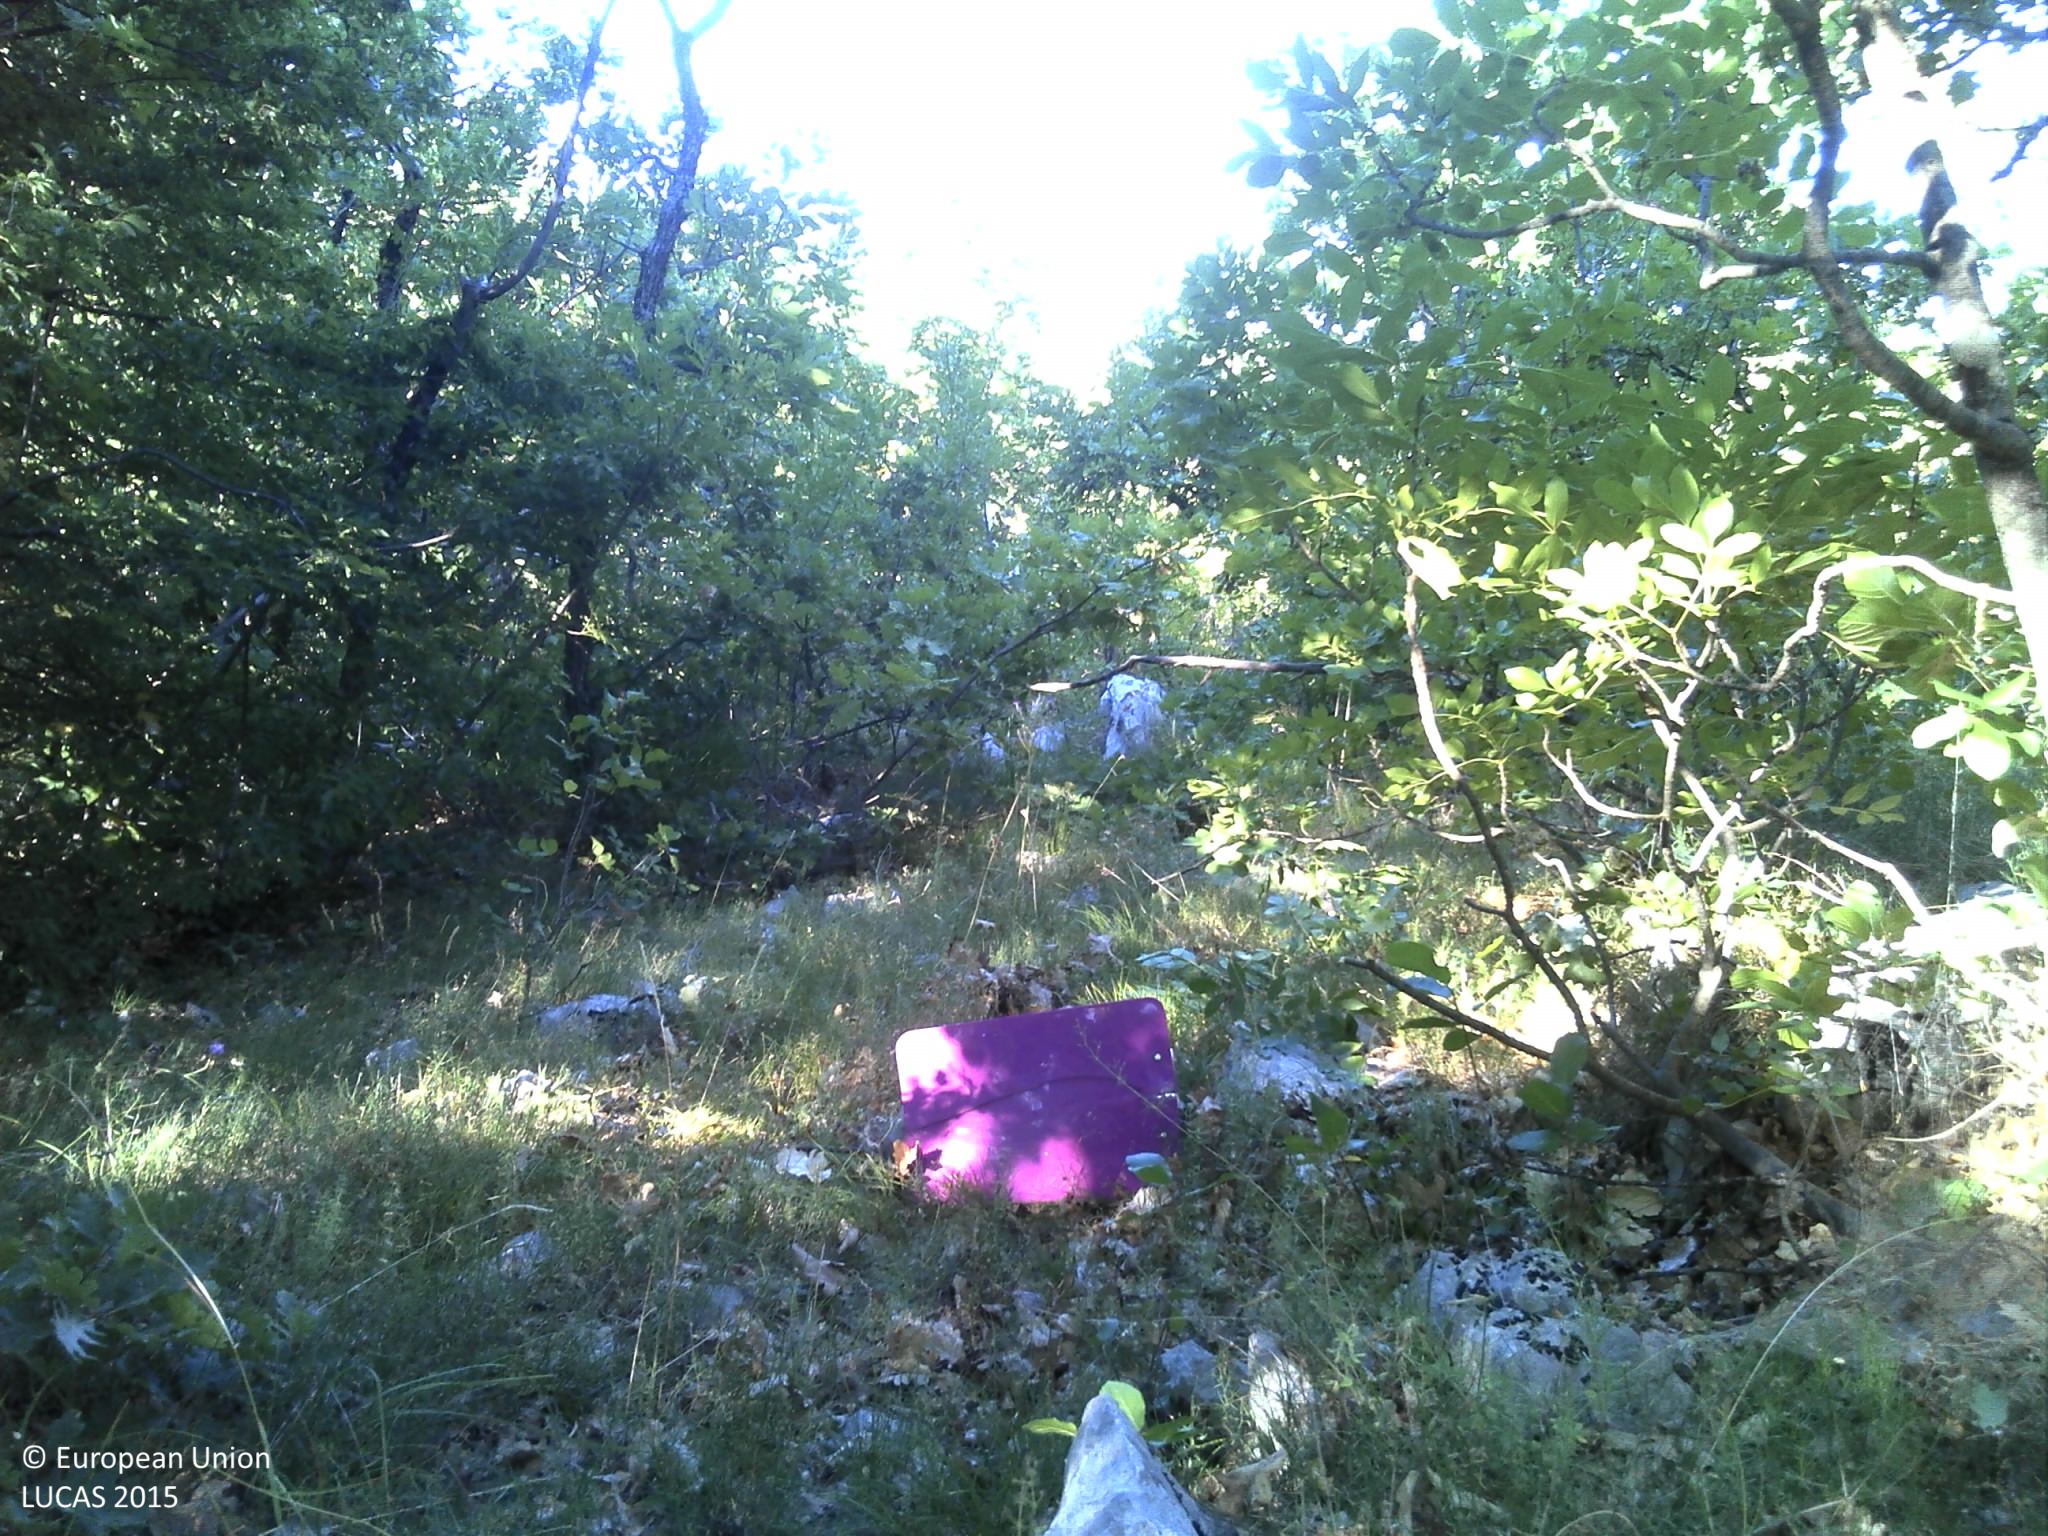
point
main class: Woodland
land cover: Other mixed woodland
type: thermophilous deciduous forest
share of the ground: > 75 %
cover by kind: broadleaved forest trees 55 %, coniferous forest trees 20 %, shrubs 10 %, herbaceous plants 10 %, consolidated bare surface 5 %
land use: Semi-natural and natural areas not in use
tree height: > 5 m
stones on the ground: < 10 %
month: July
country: HR
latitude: 43.5392
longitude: 16.9344
